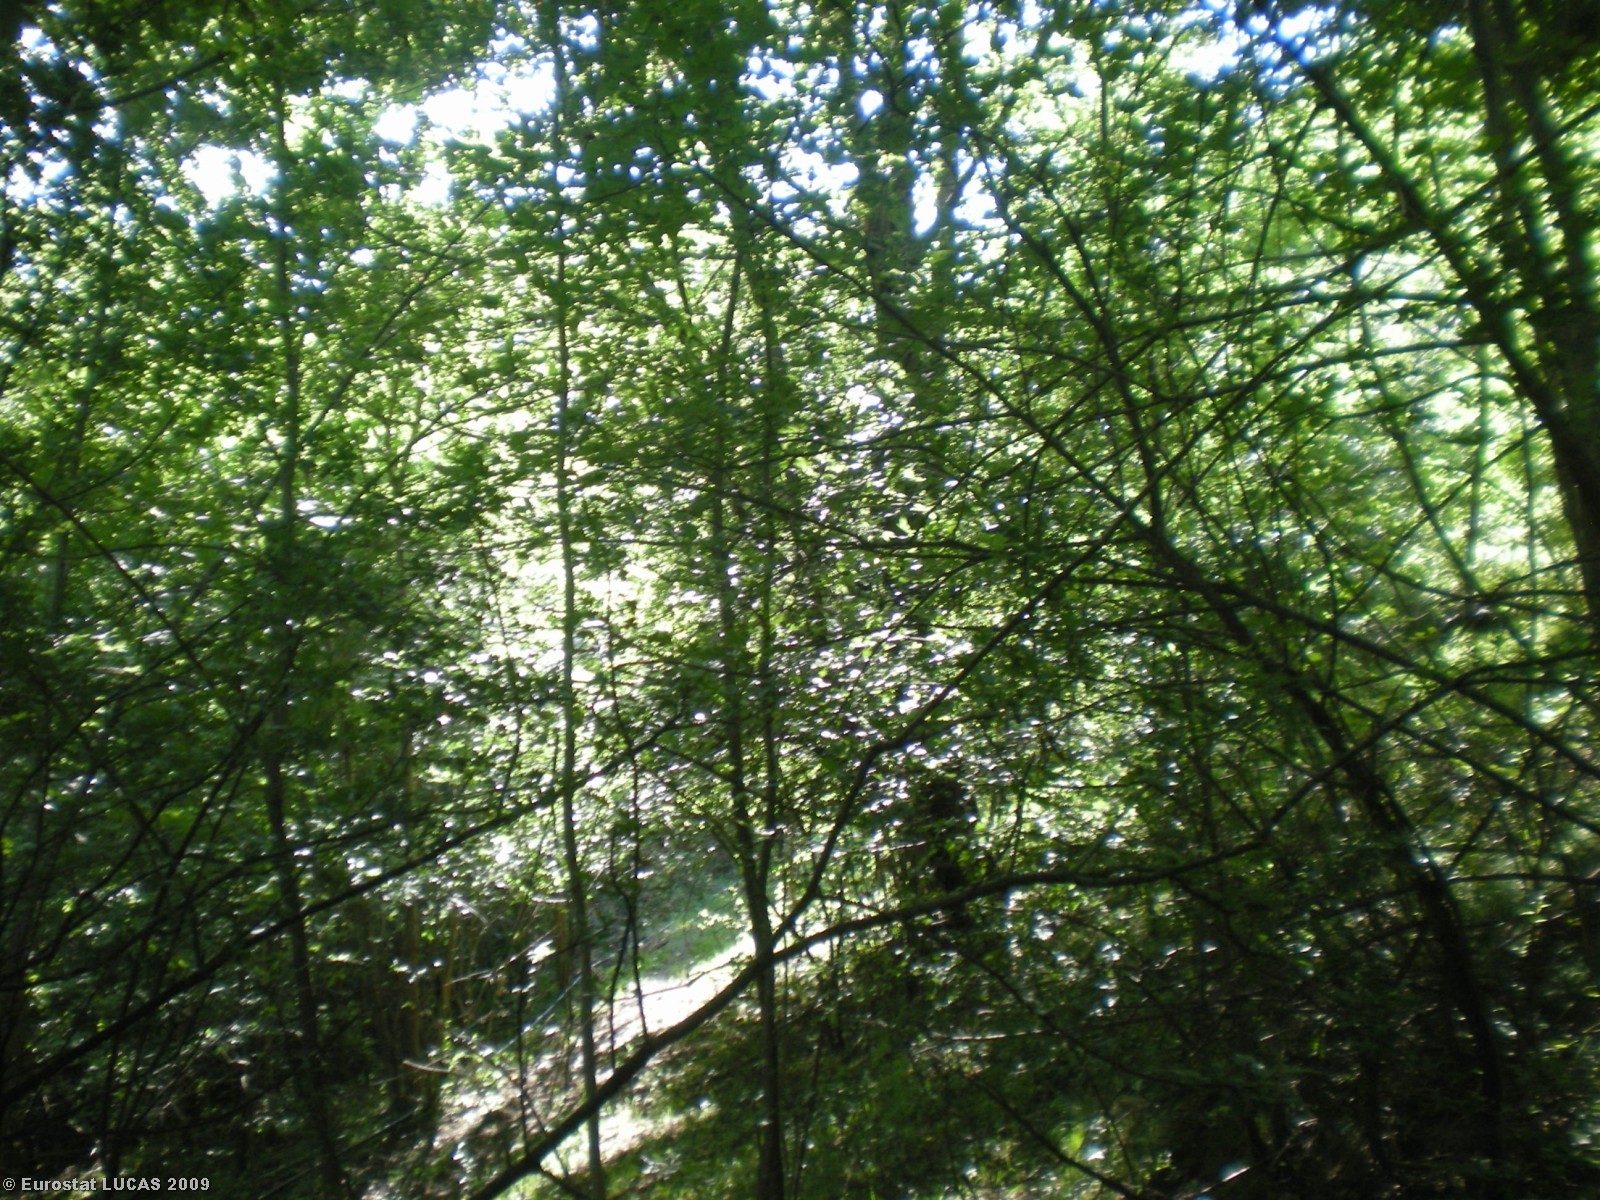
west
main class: Woodland
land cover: Broadleaved woodland
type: mountainous beech forest
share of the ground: > 75 %
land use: Forestry
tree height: > 5 m
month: June
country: IT
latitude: 44.5827
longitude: 7.1716
